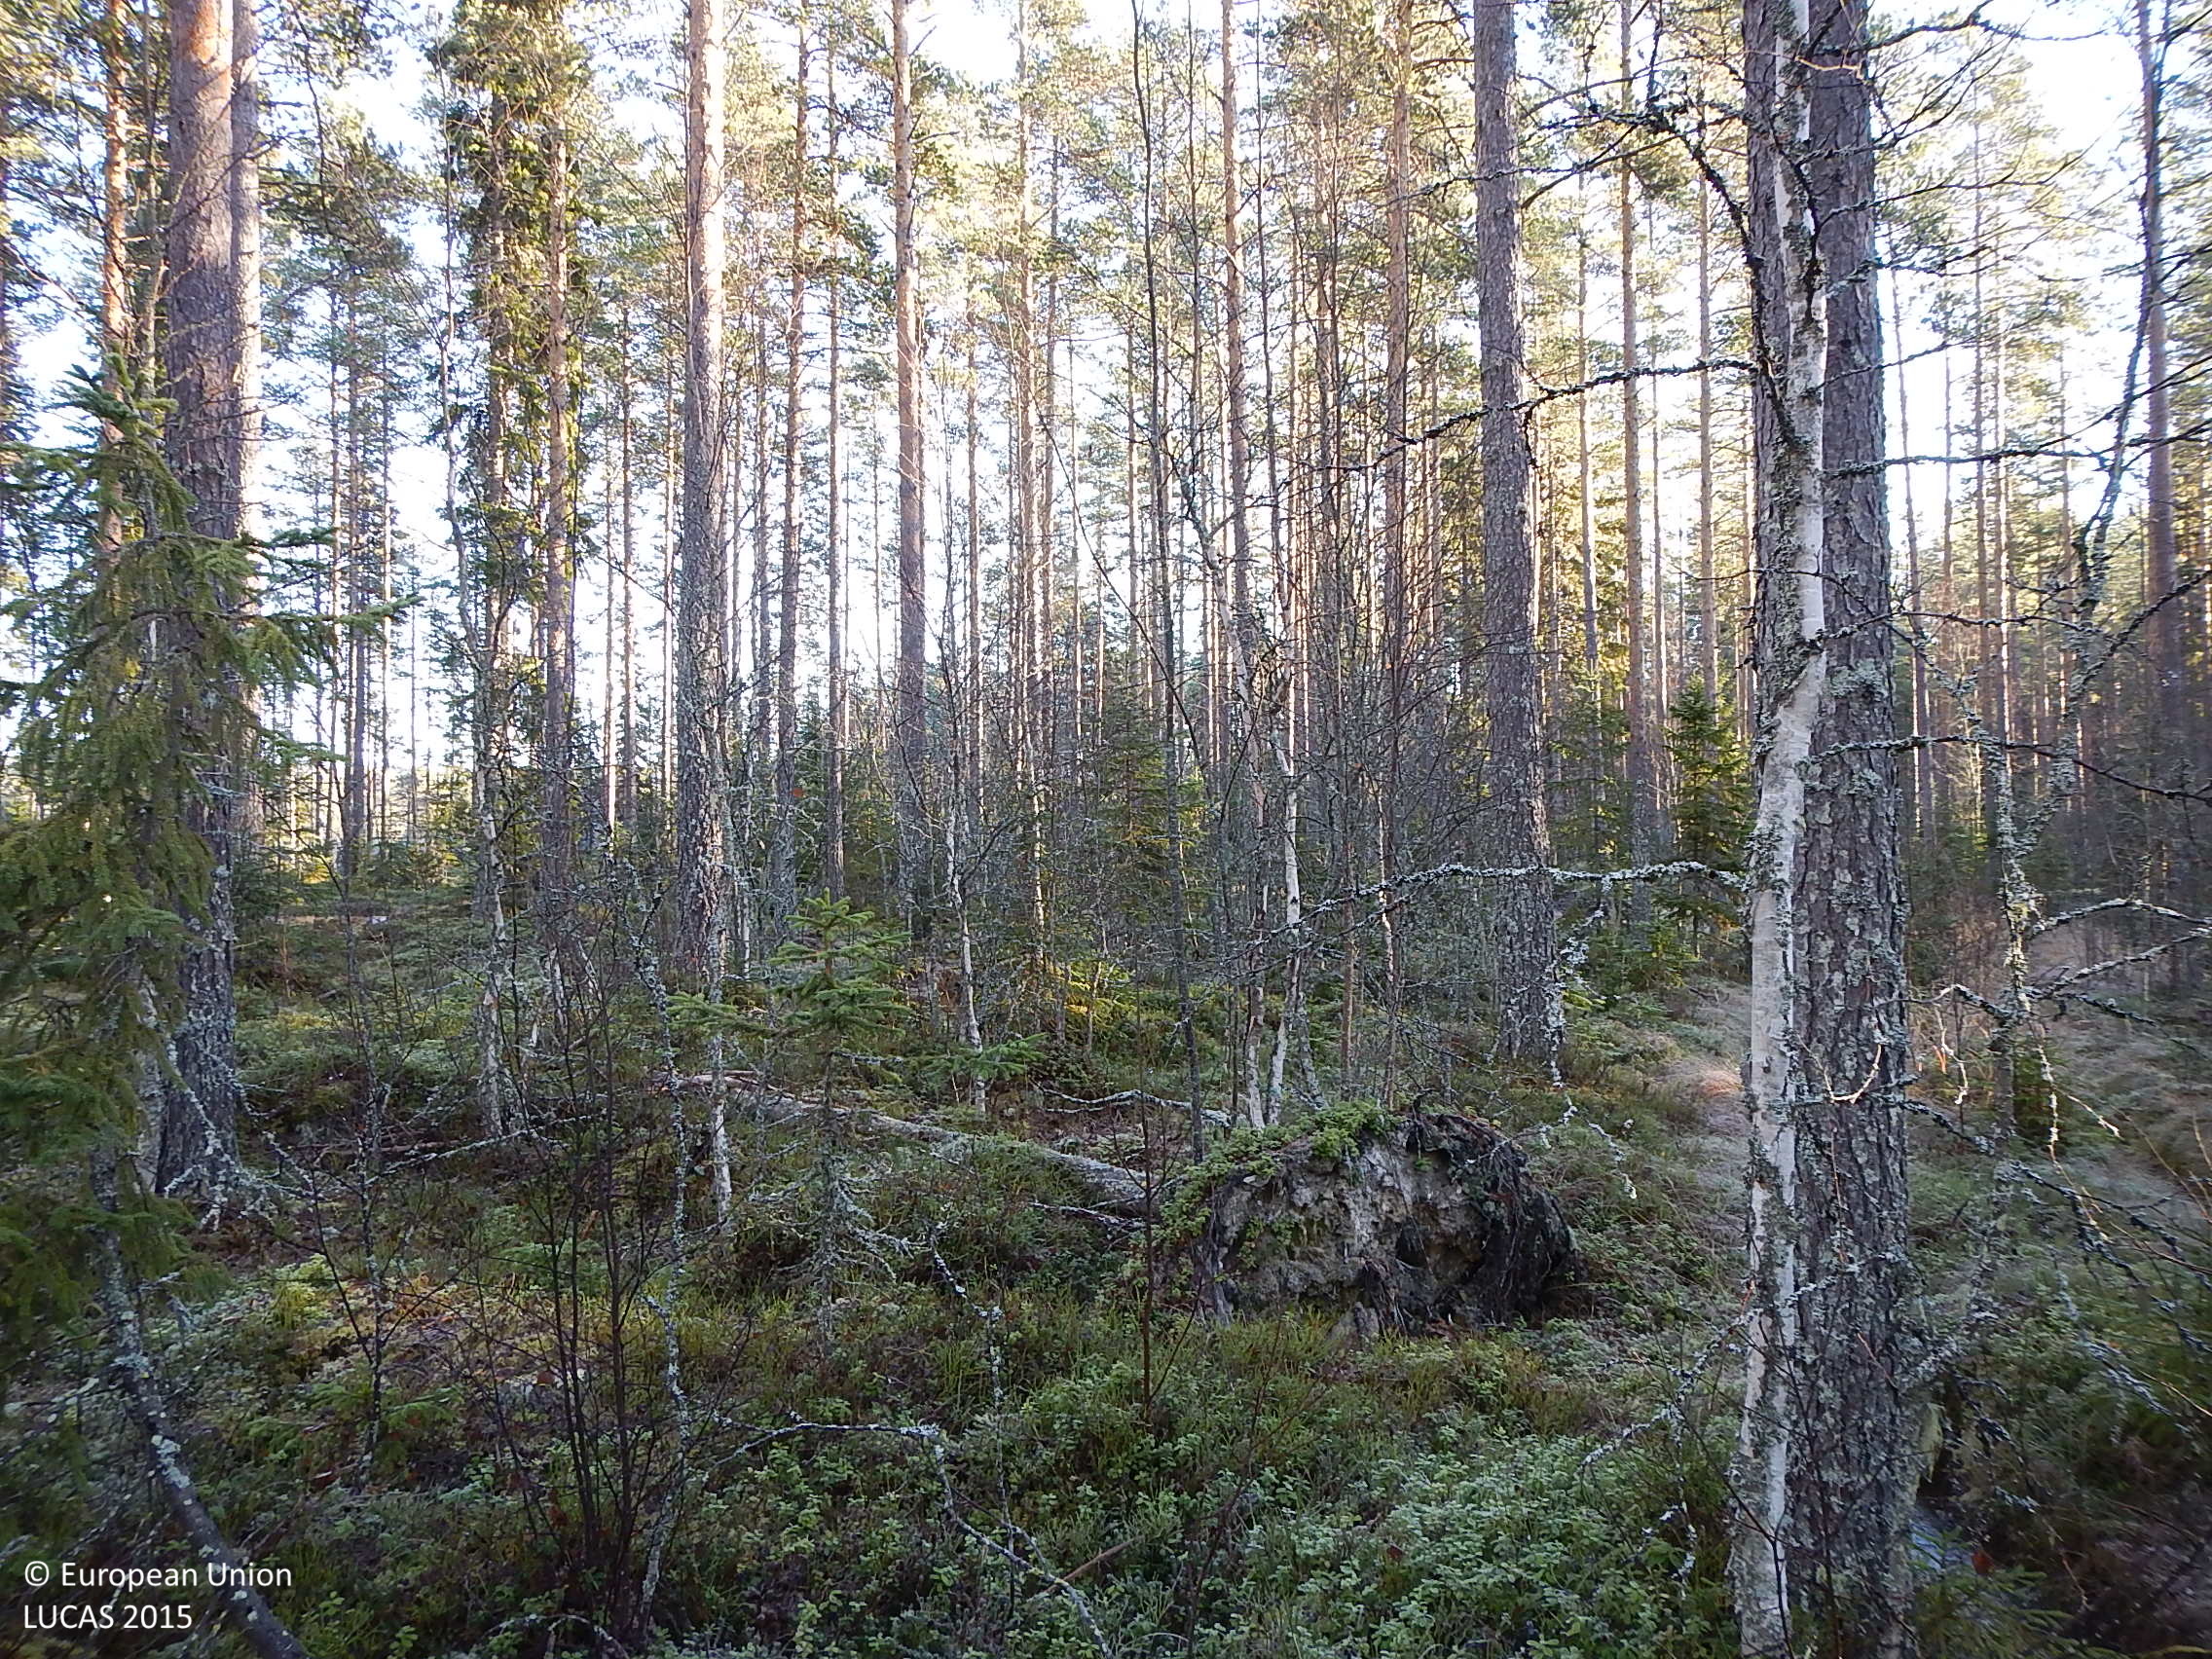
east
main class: Woodland
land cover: Pine dominated coniferous woodland
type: mire and swamp forests
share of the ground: 50 - 75 %
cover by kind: coniferous forest trees 60 %, shrubs 25 %, lichens and mosses 10 %, broadleaved forest trees 5 %
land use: Forestry
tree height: > 5 m
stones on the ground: < 10 %
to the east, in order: Pine dominated coniferous woodland
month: November
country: SE
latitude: 61.5726
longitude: 15.9528
